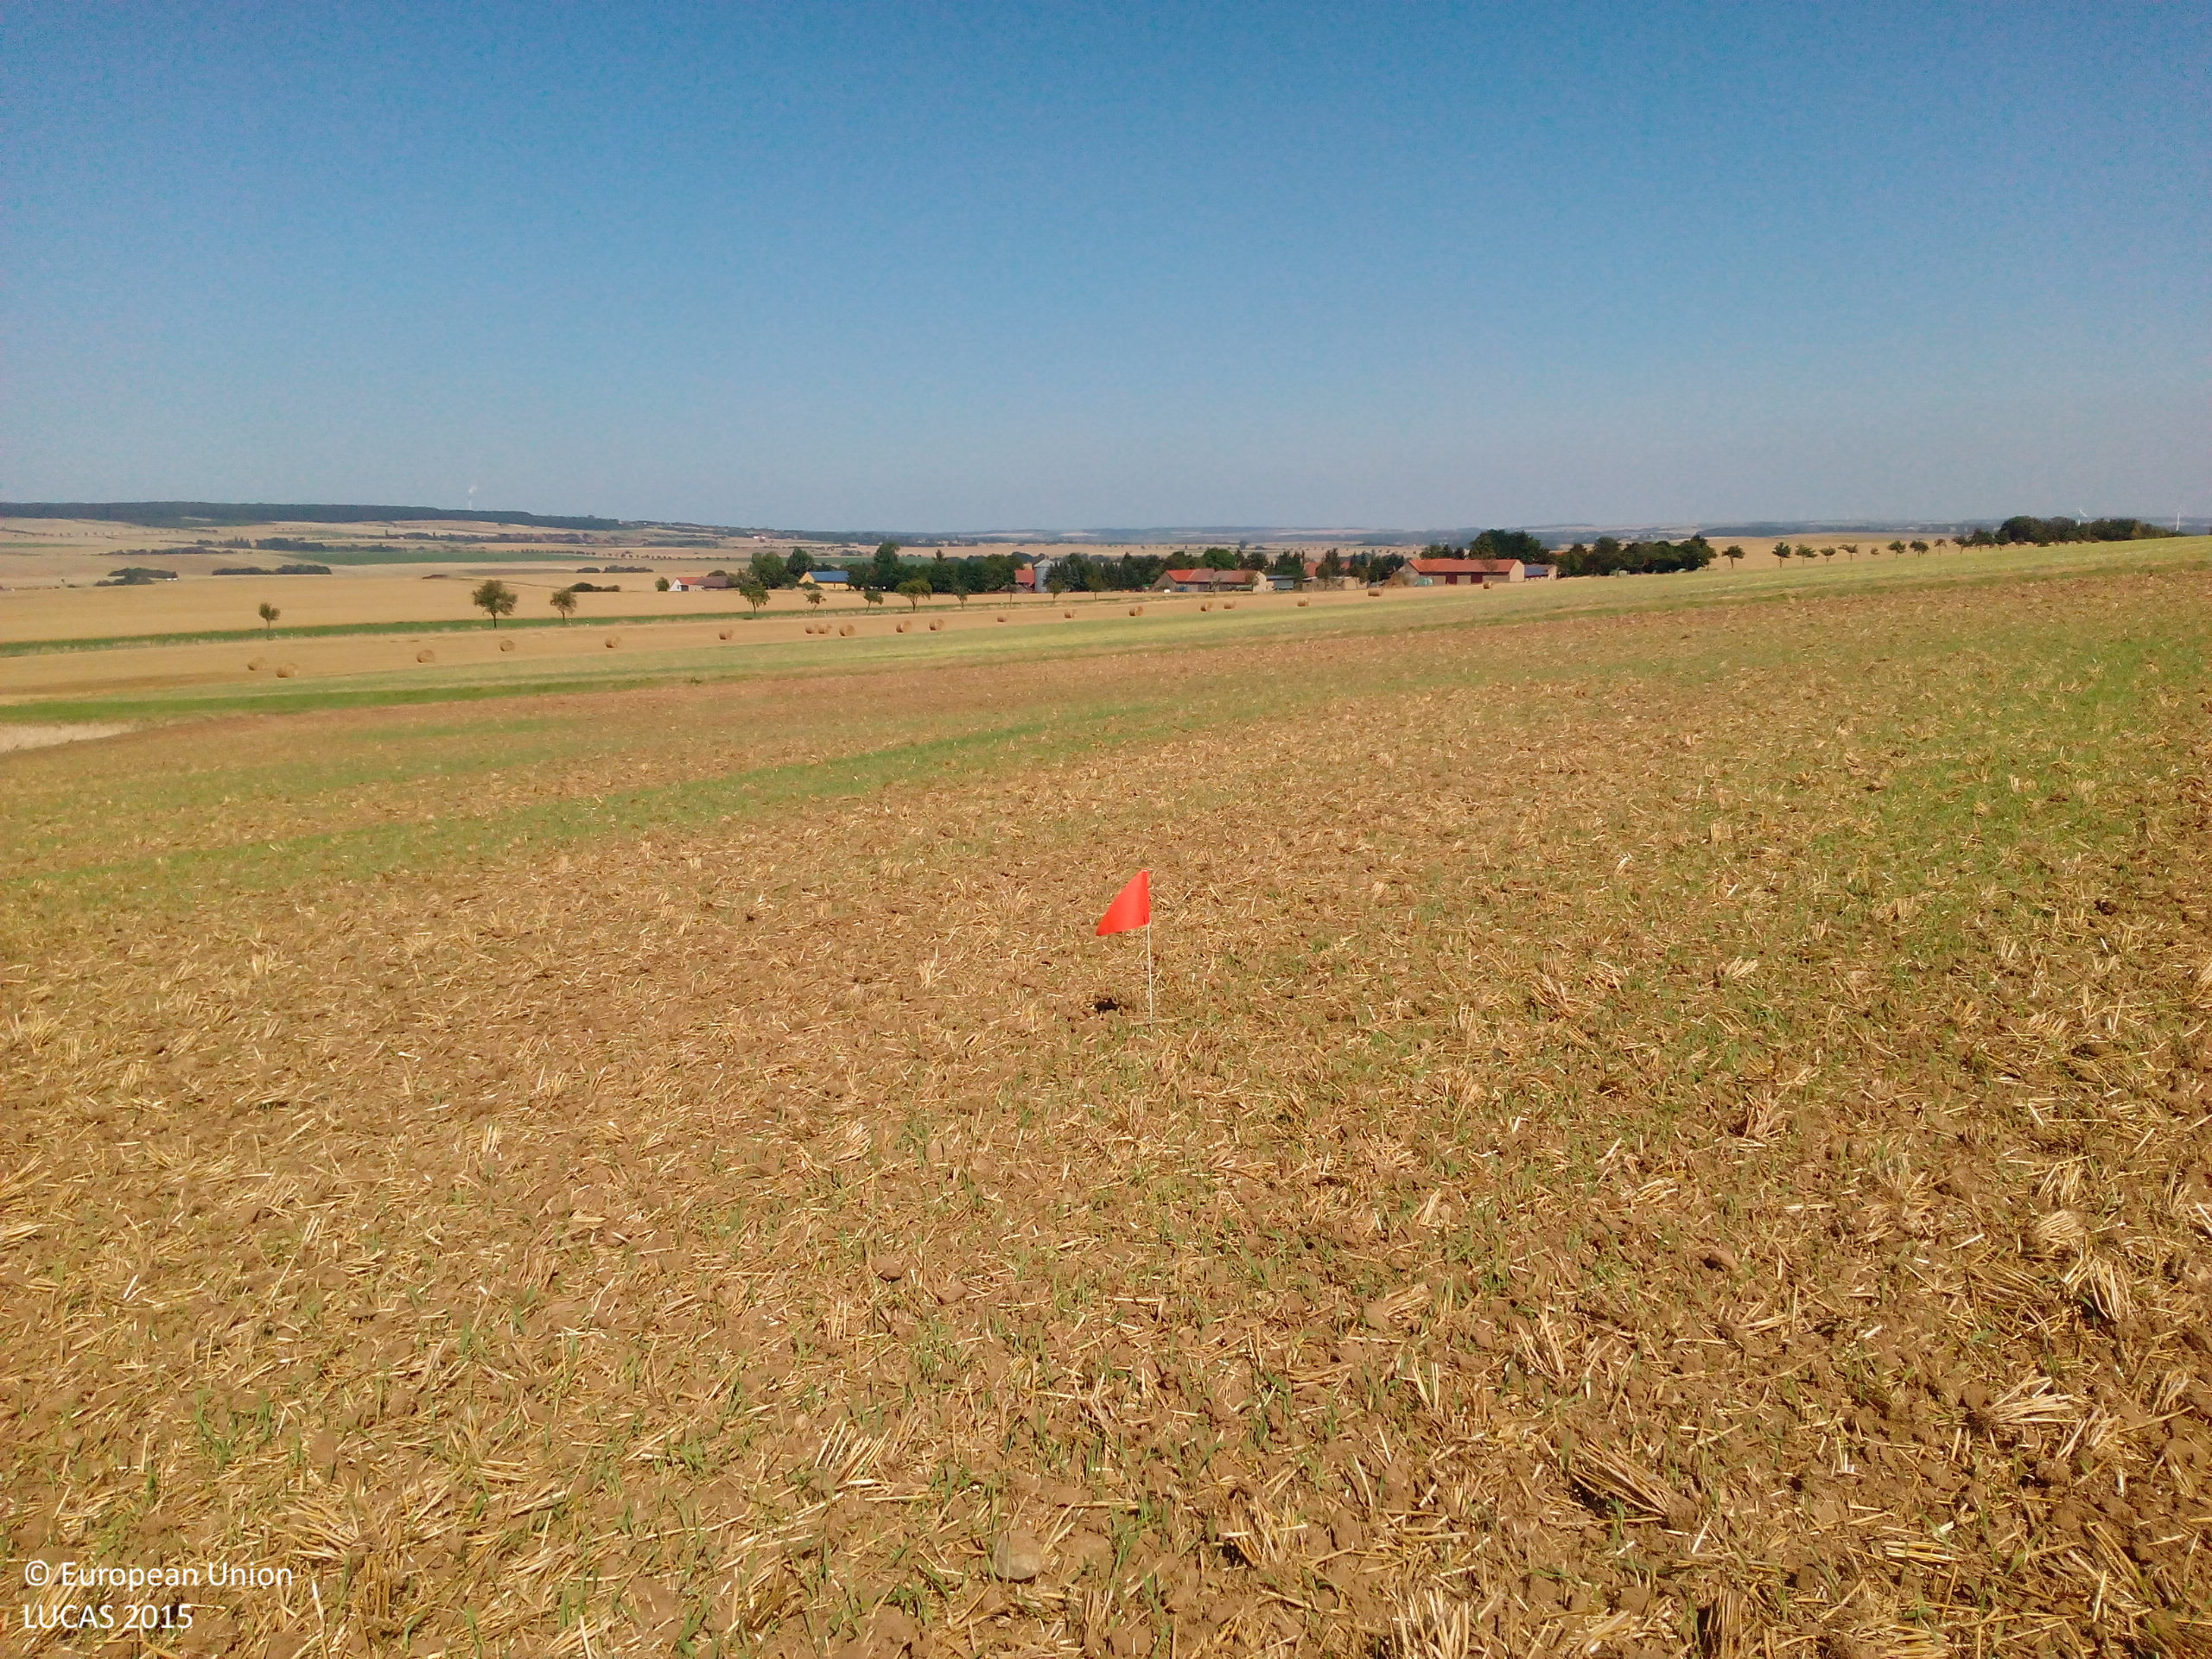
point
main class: Cropland
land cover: Barley
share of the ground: < 10 %
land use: Agriculture (excluding fallow land and kitchen gardens)
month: August
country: DE
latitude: 52.0867
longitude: 10.8608
